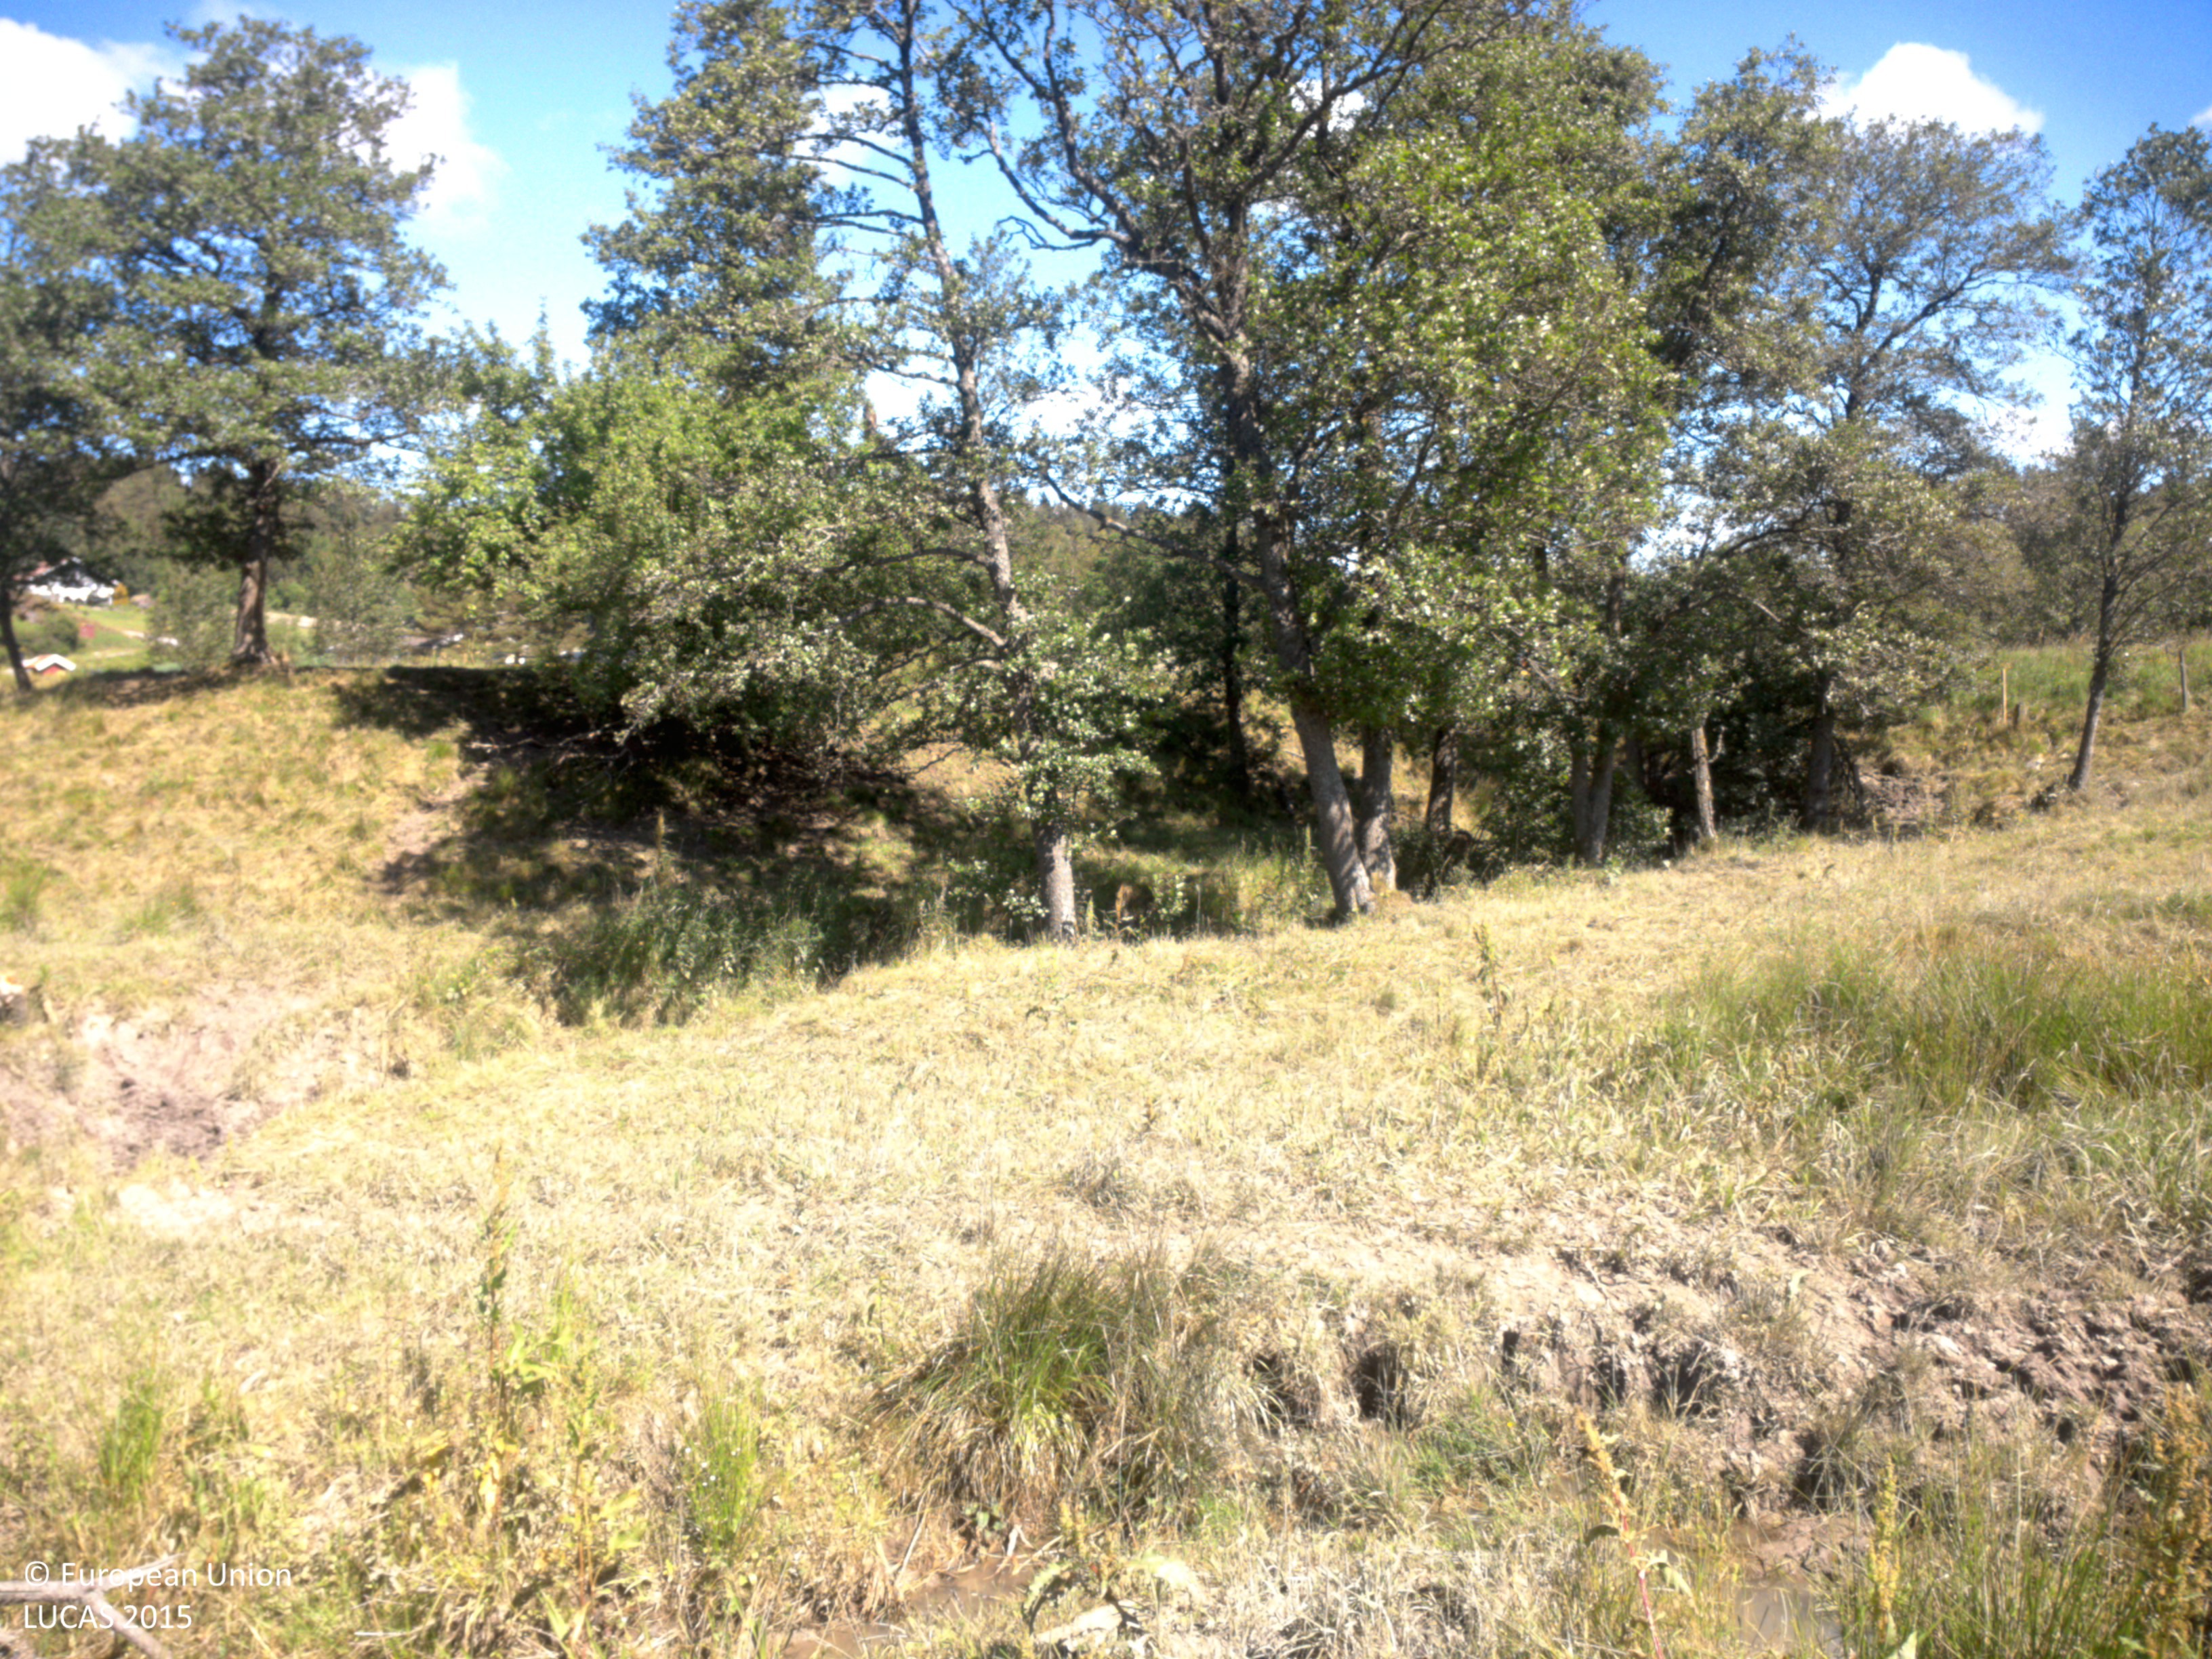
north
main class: Grassland
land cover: Grassland with sparse tree/shrub cover
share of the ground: > 75 %
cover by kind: herbaceous plants 95 %, broadleaved forest trees 5 %
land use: Agriculture (excluding fallow land and kitchen gardens)
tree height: > 5 m
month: June
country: SE
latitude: 58.4979
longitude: 11.5923
